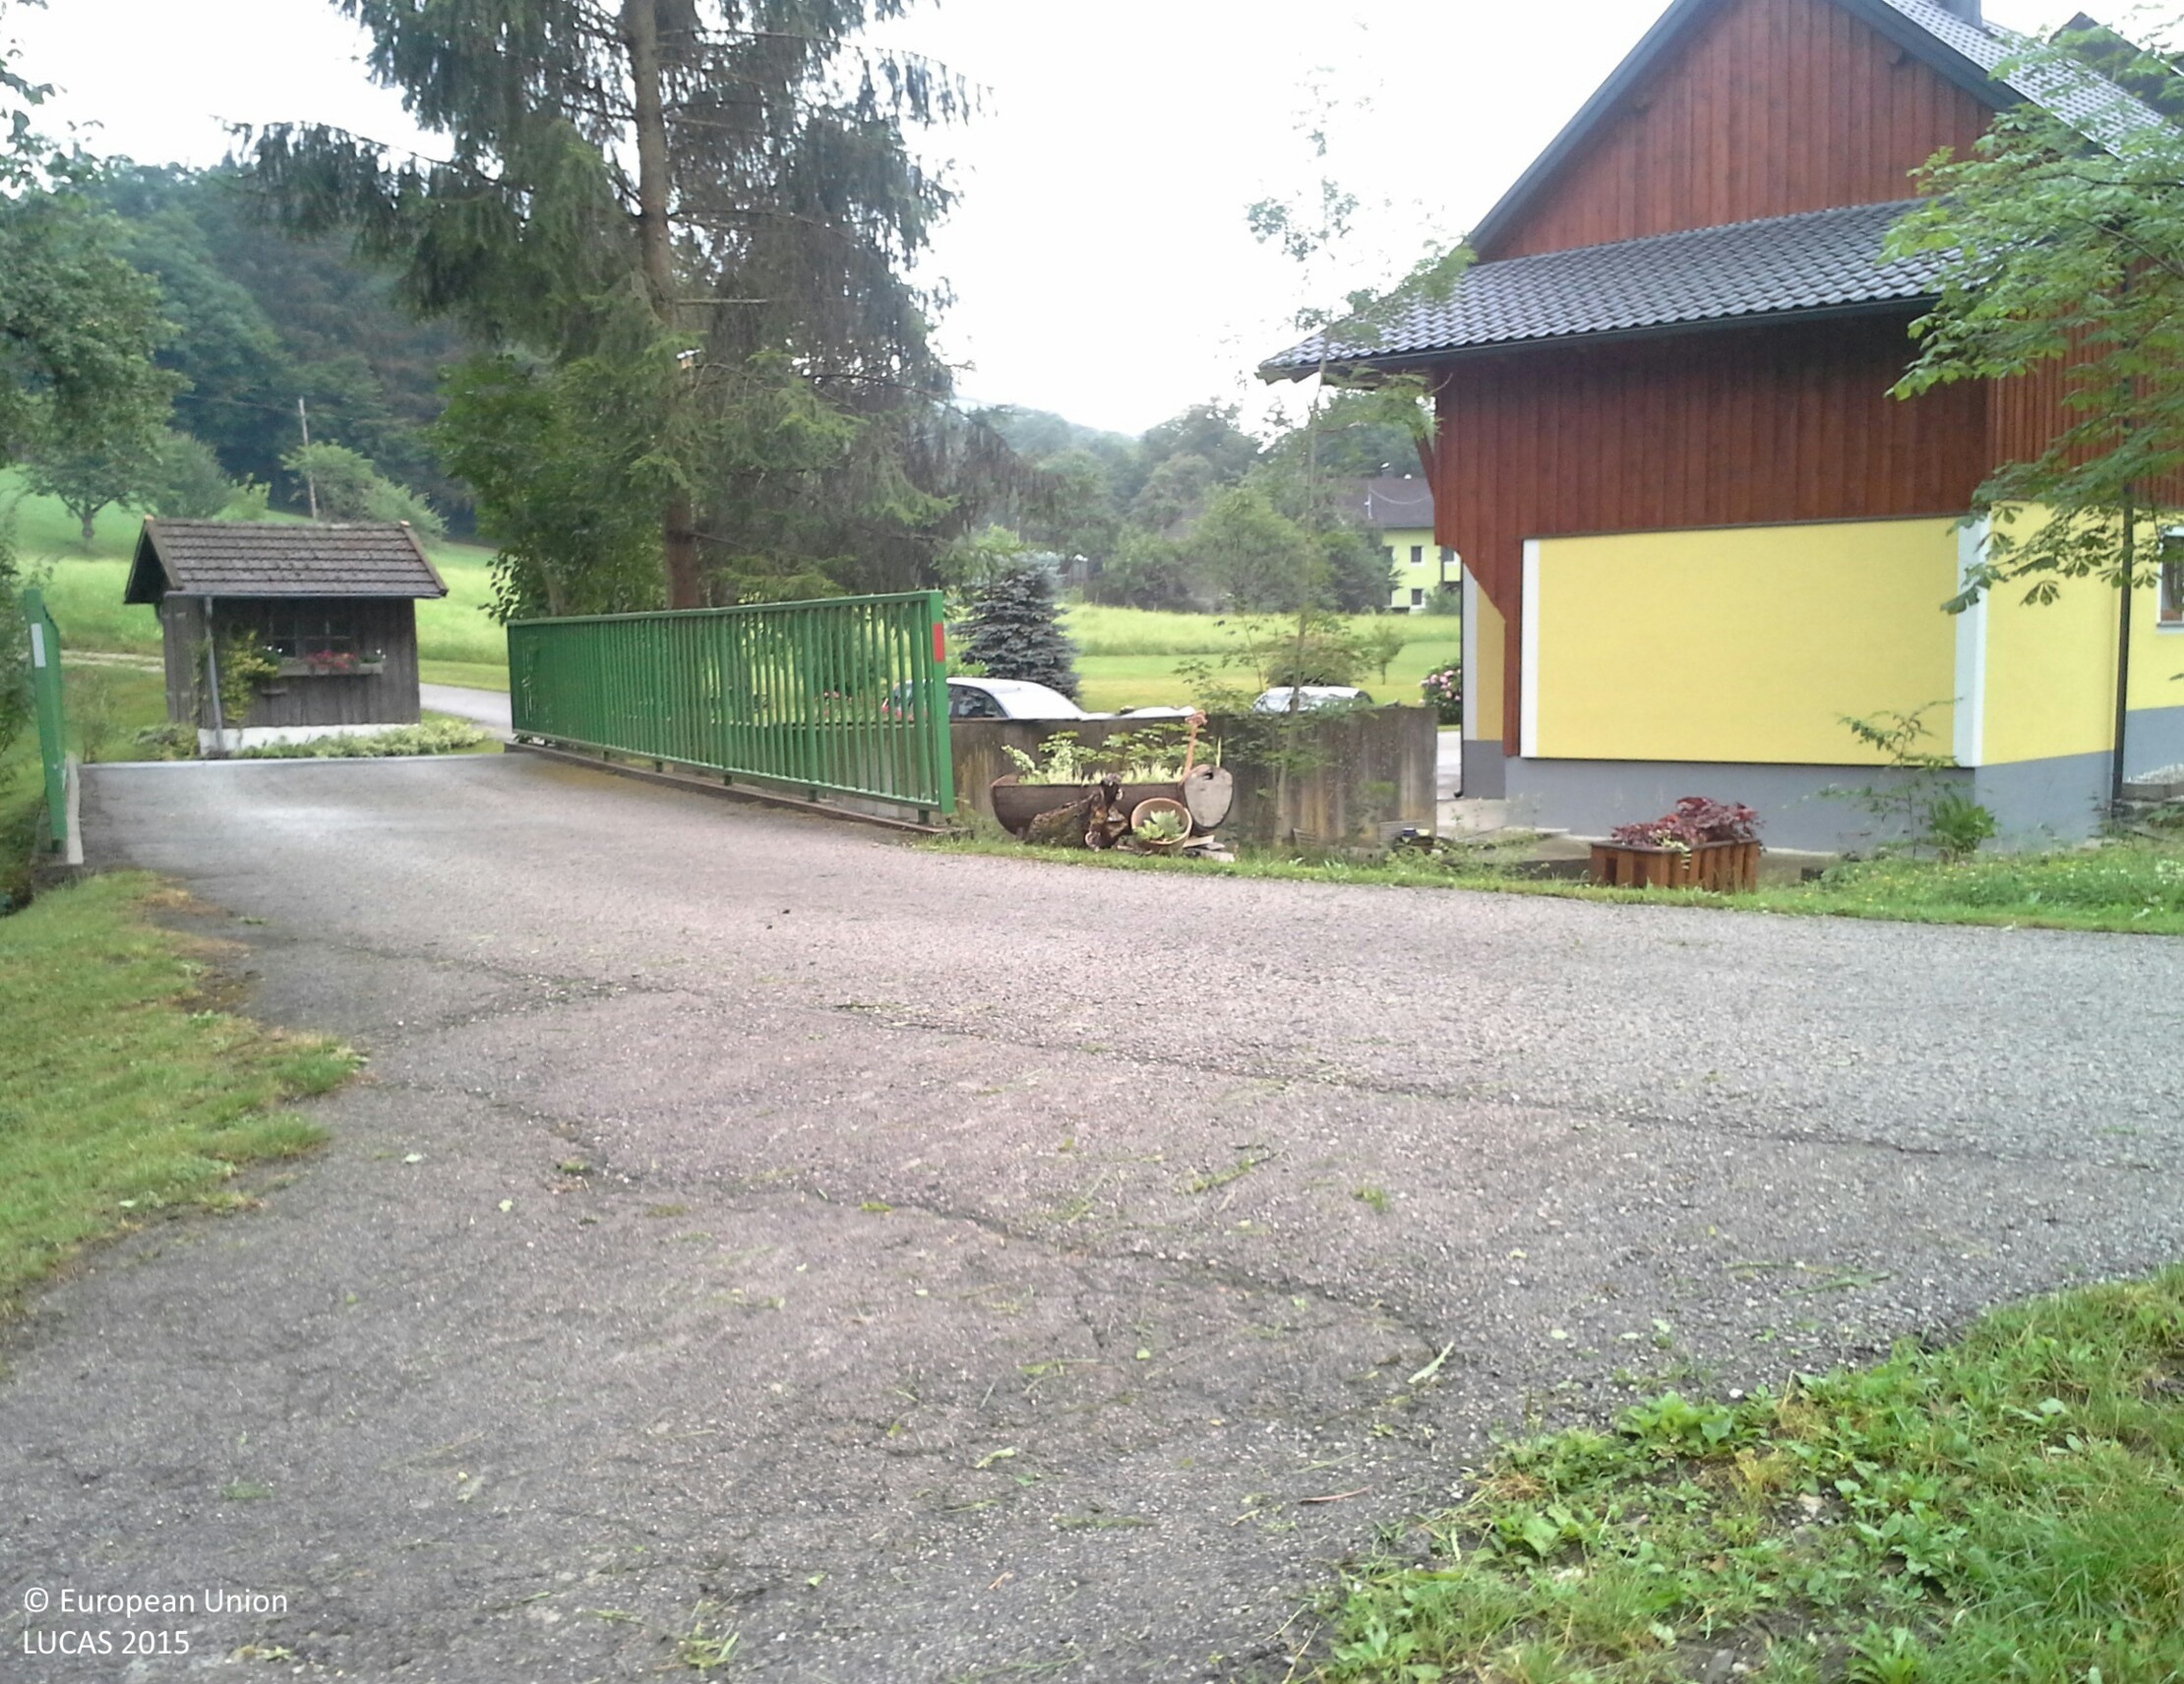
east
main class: Grassland
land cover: Grassland without tree/shrub cover
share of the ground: > 75 %
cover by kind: herbaceous plants 100 %
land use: Agriculture (excluding fallow land and kitchen gardens)
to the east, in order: Grassland without tree/shrub cover; Paved roads, cycling and walking lanes; Rivers and streams; Artificial constructions in urban areas; Grassland without tree/shrub cover; Apple fruit; Grassland without tree/shrub cover; Electric lines; Grassland without tree/shrub cover; Broadleaved woodland; Rivers and streams; Spruce dominated mixed woodland; Broadleaved woodland
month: July
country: AT
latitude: 48.0271
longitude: 14.8415
